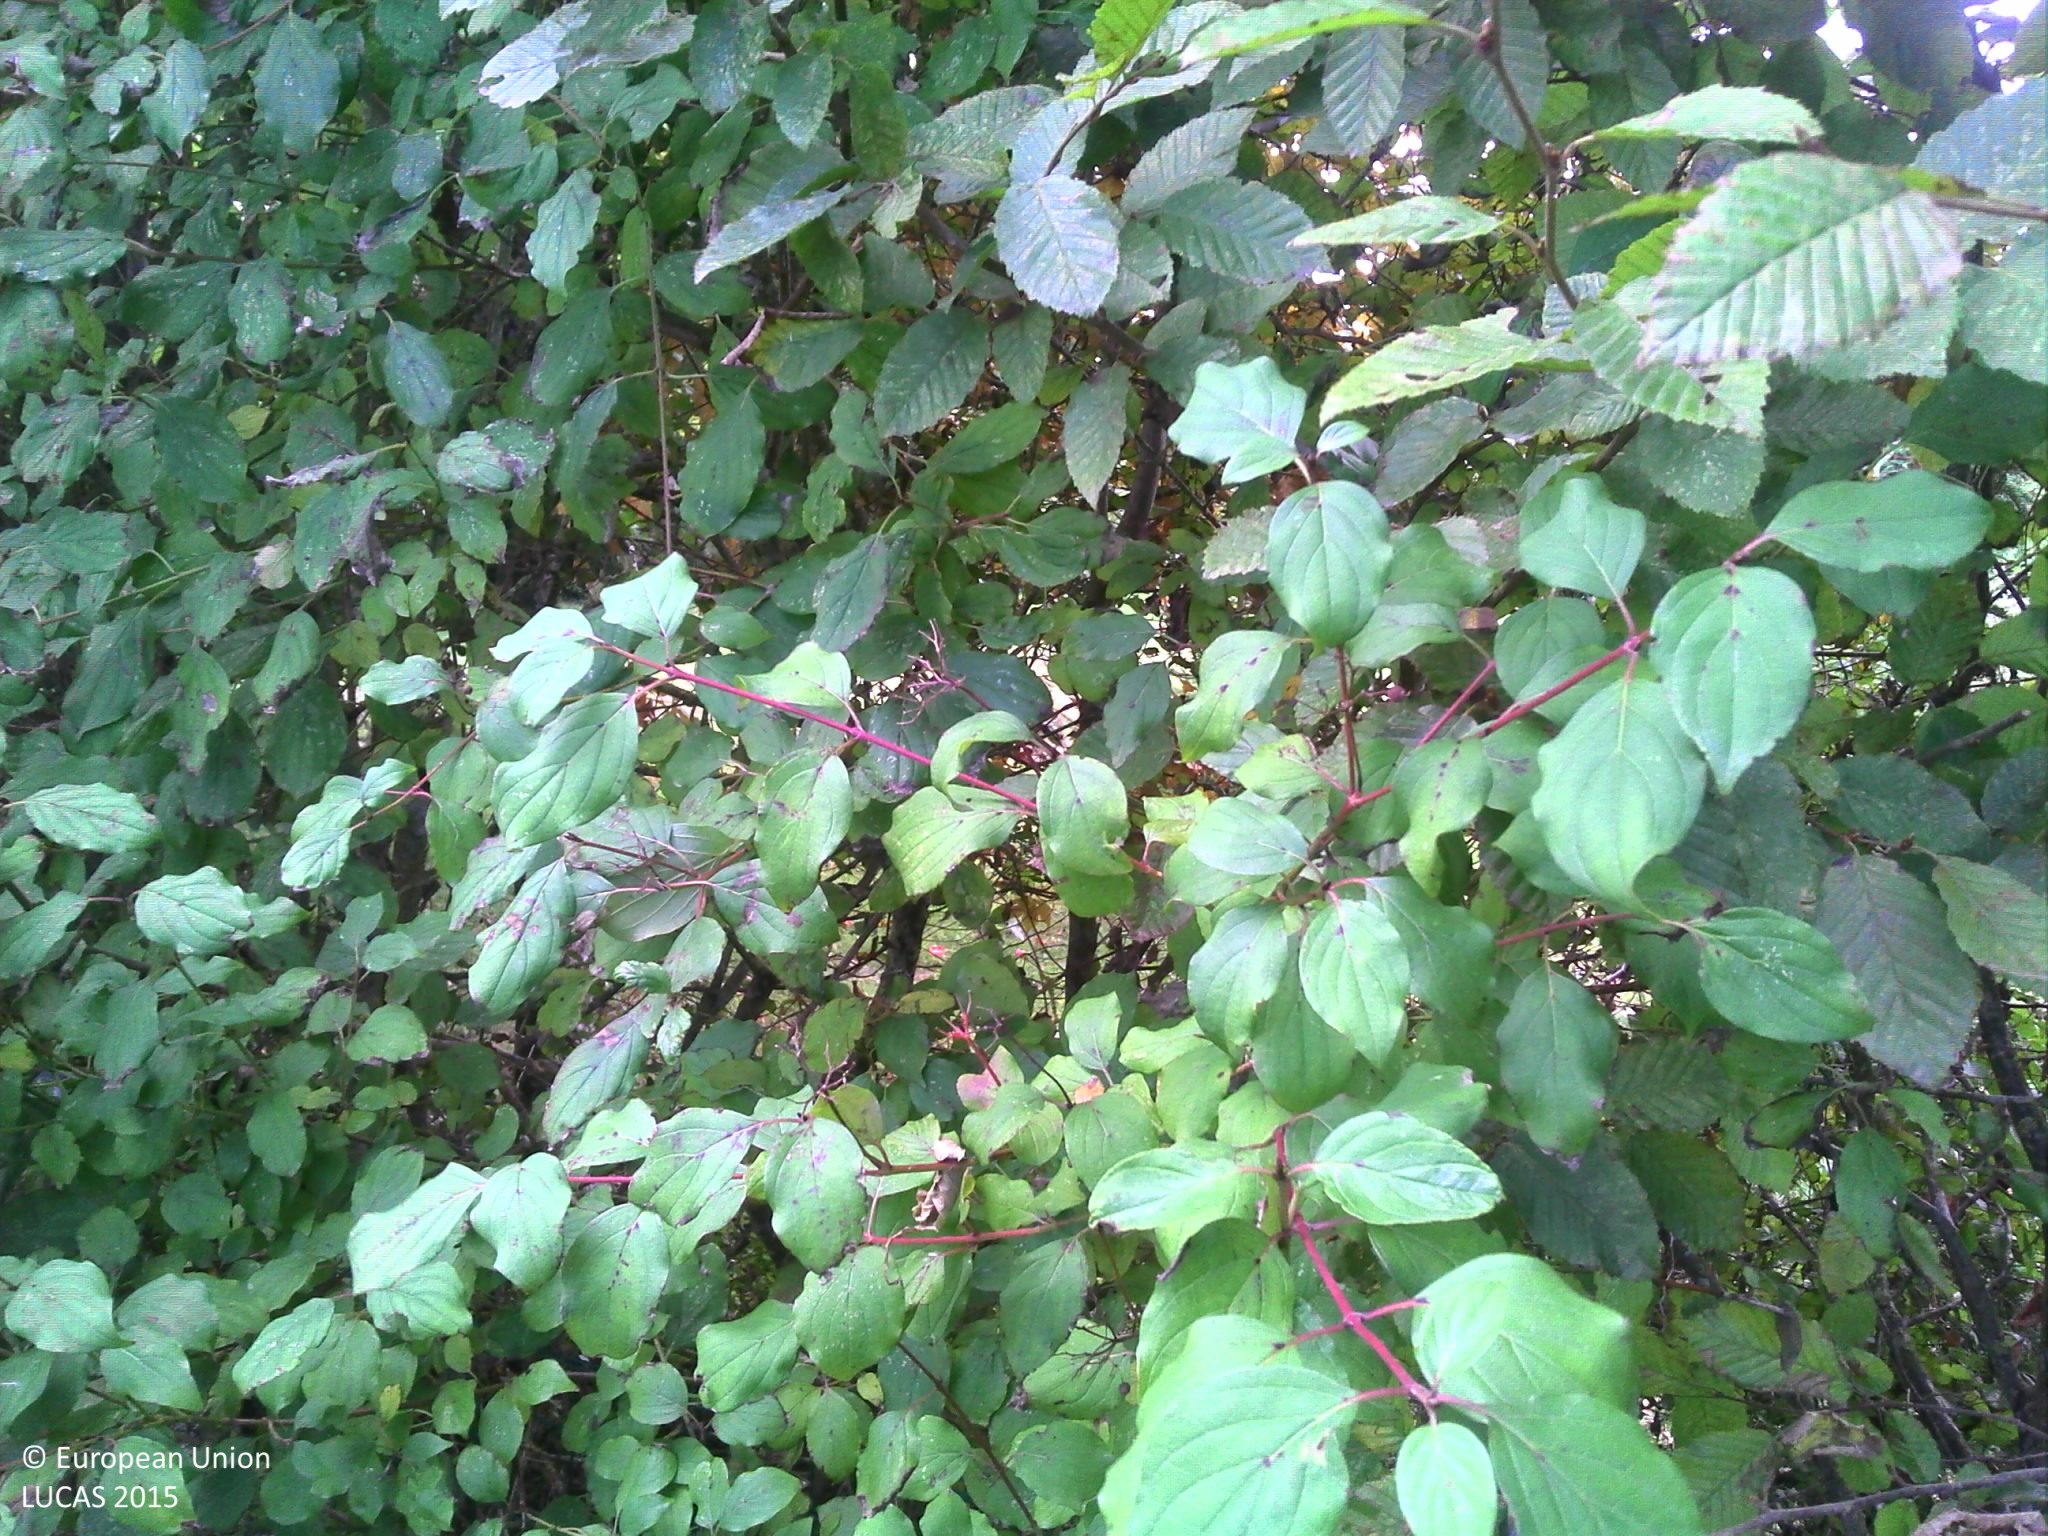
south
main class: Grassland
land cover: Grassland with sparse tree/shrub cover
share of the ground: > 75 %
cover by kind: herbaceous plants 95 %, coniferous forest trees 5 %
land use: Residential
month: September
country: FR
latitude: 46.9843
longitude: 1.4286
